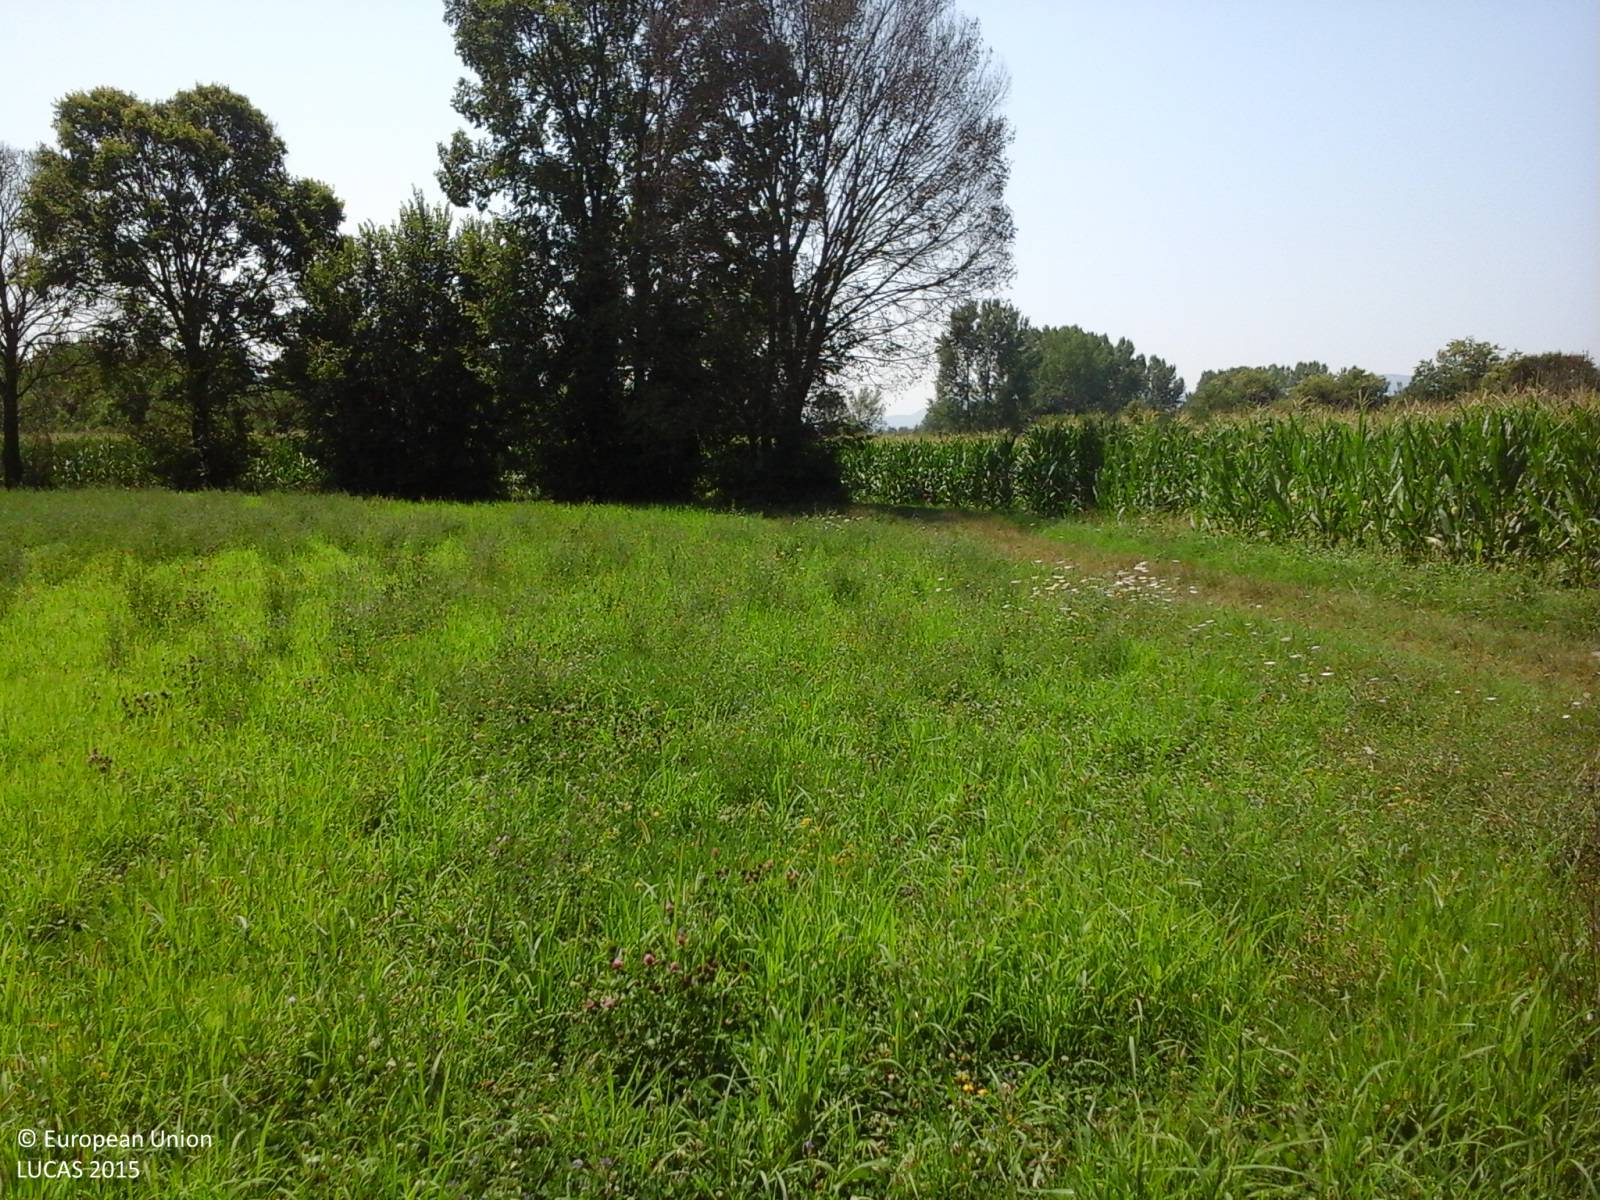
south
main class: Cropland
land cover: Temporary grasslands
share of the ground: > 75 %
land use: Agriculture (excluding fallow land and kitchen gardens)
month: August
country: IT
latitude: 41.3113
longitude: 14.3673
